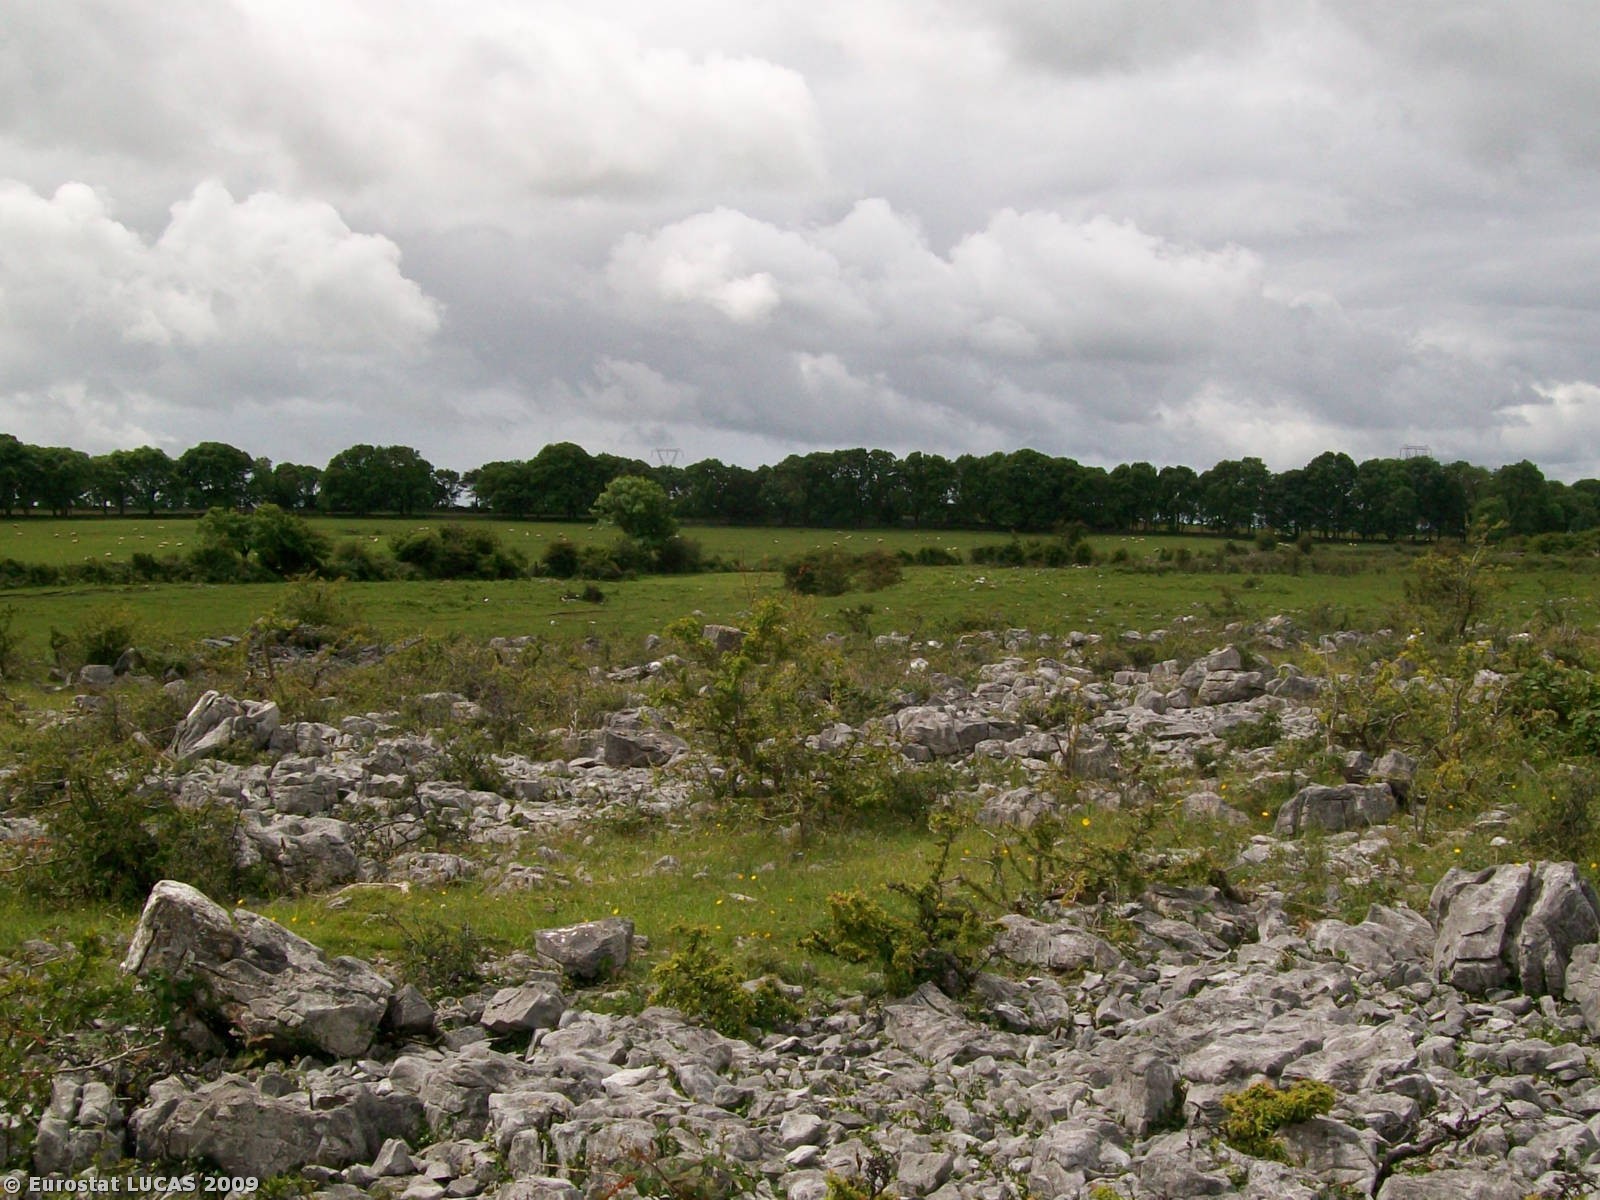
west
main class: Grassland
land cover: Grassland with sparse tree/shrub cover
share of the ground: > 75 %
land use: Agriculture (excluding fallow land and kitchen gardens)
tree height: < 5 m
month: June
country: IE
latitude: 53.3492
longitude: -8.8179
